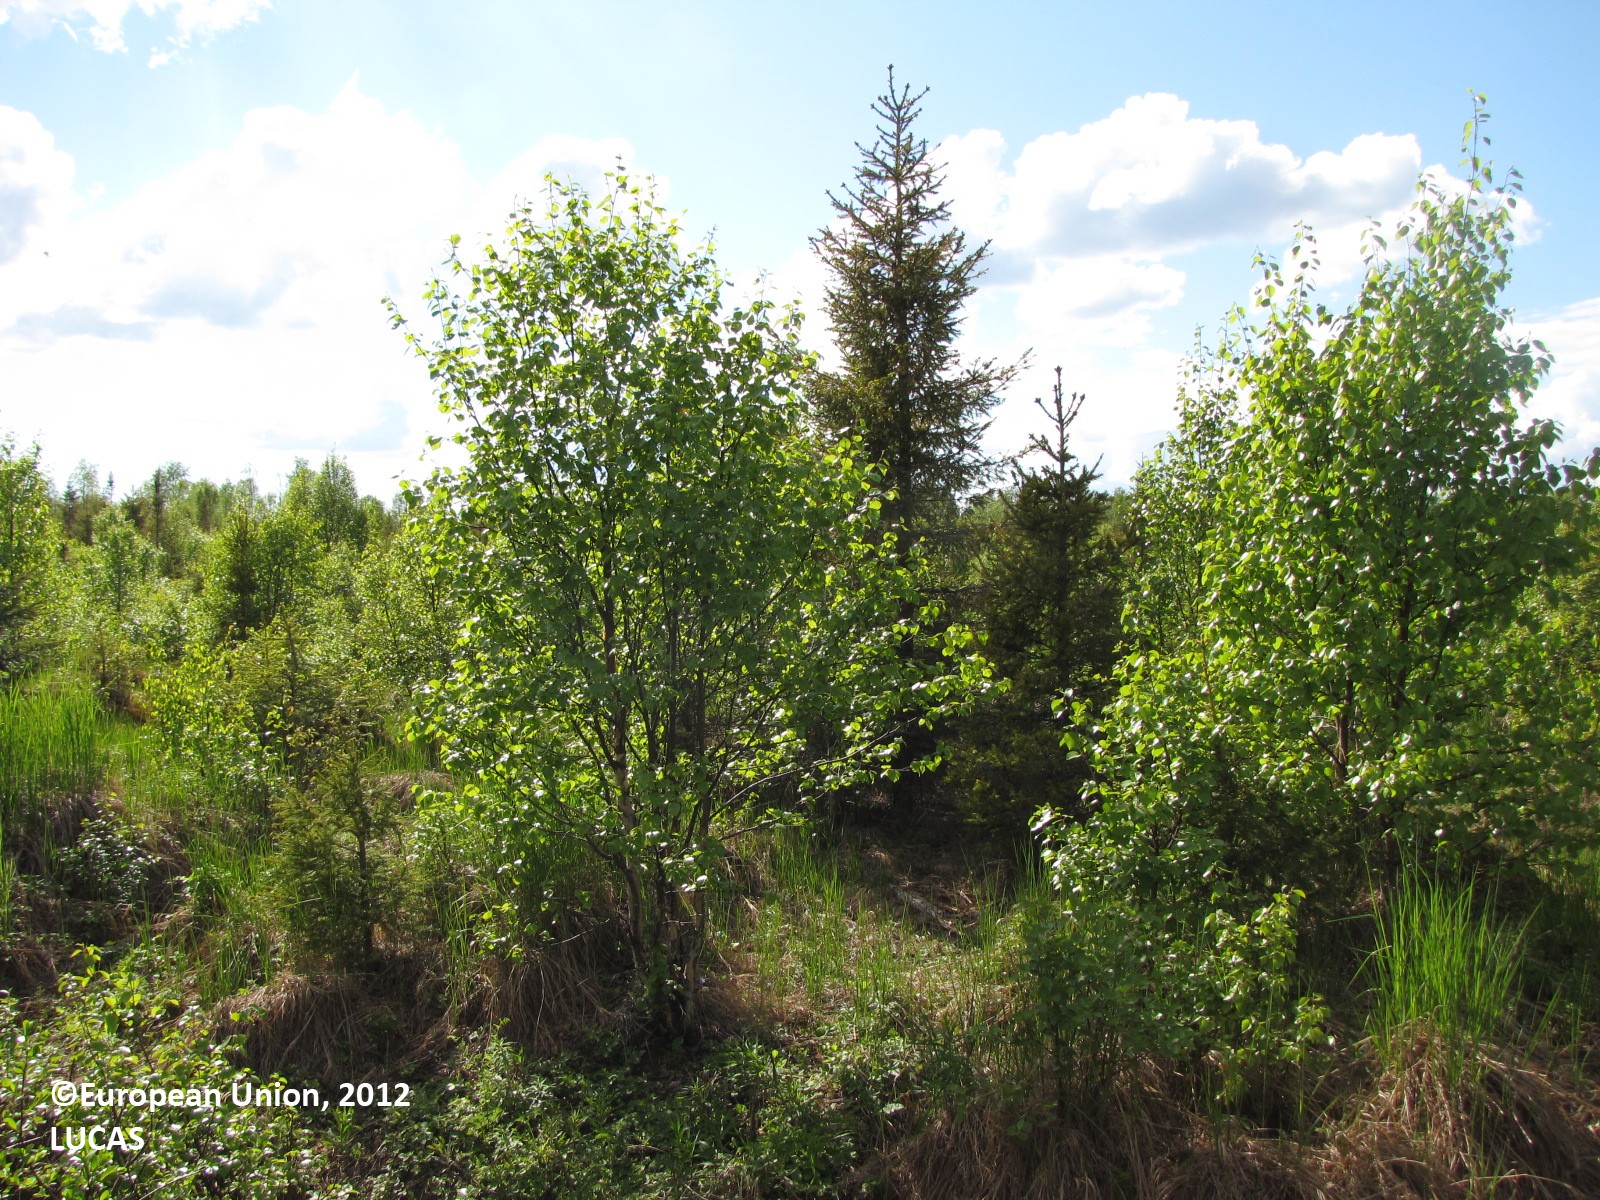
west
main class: Woodland
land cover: Other mixed woodland
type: boreal forest
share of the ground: 50 - 75 %
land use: Forestry
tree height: < 5 m
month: June
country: FI
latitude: 66.0121
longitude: 24.5343
